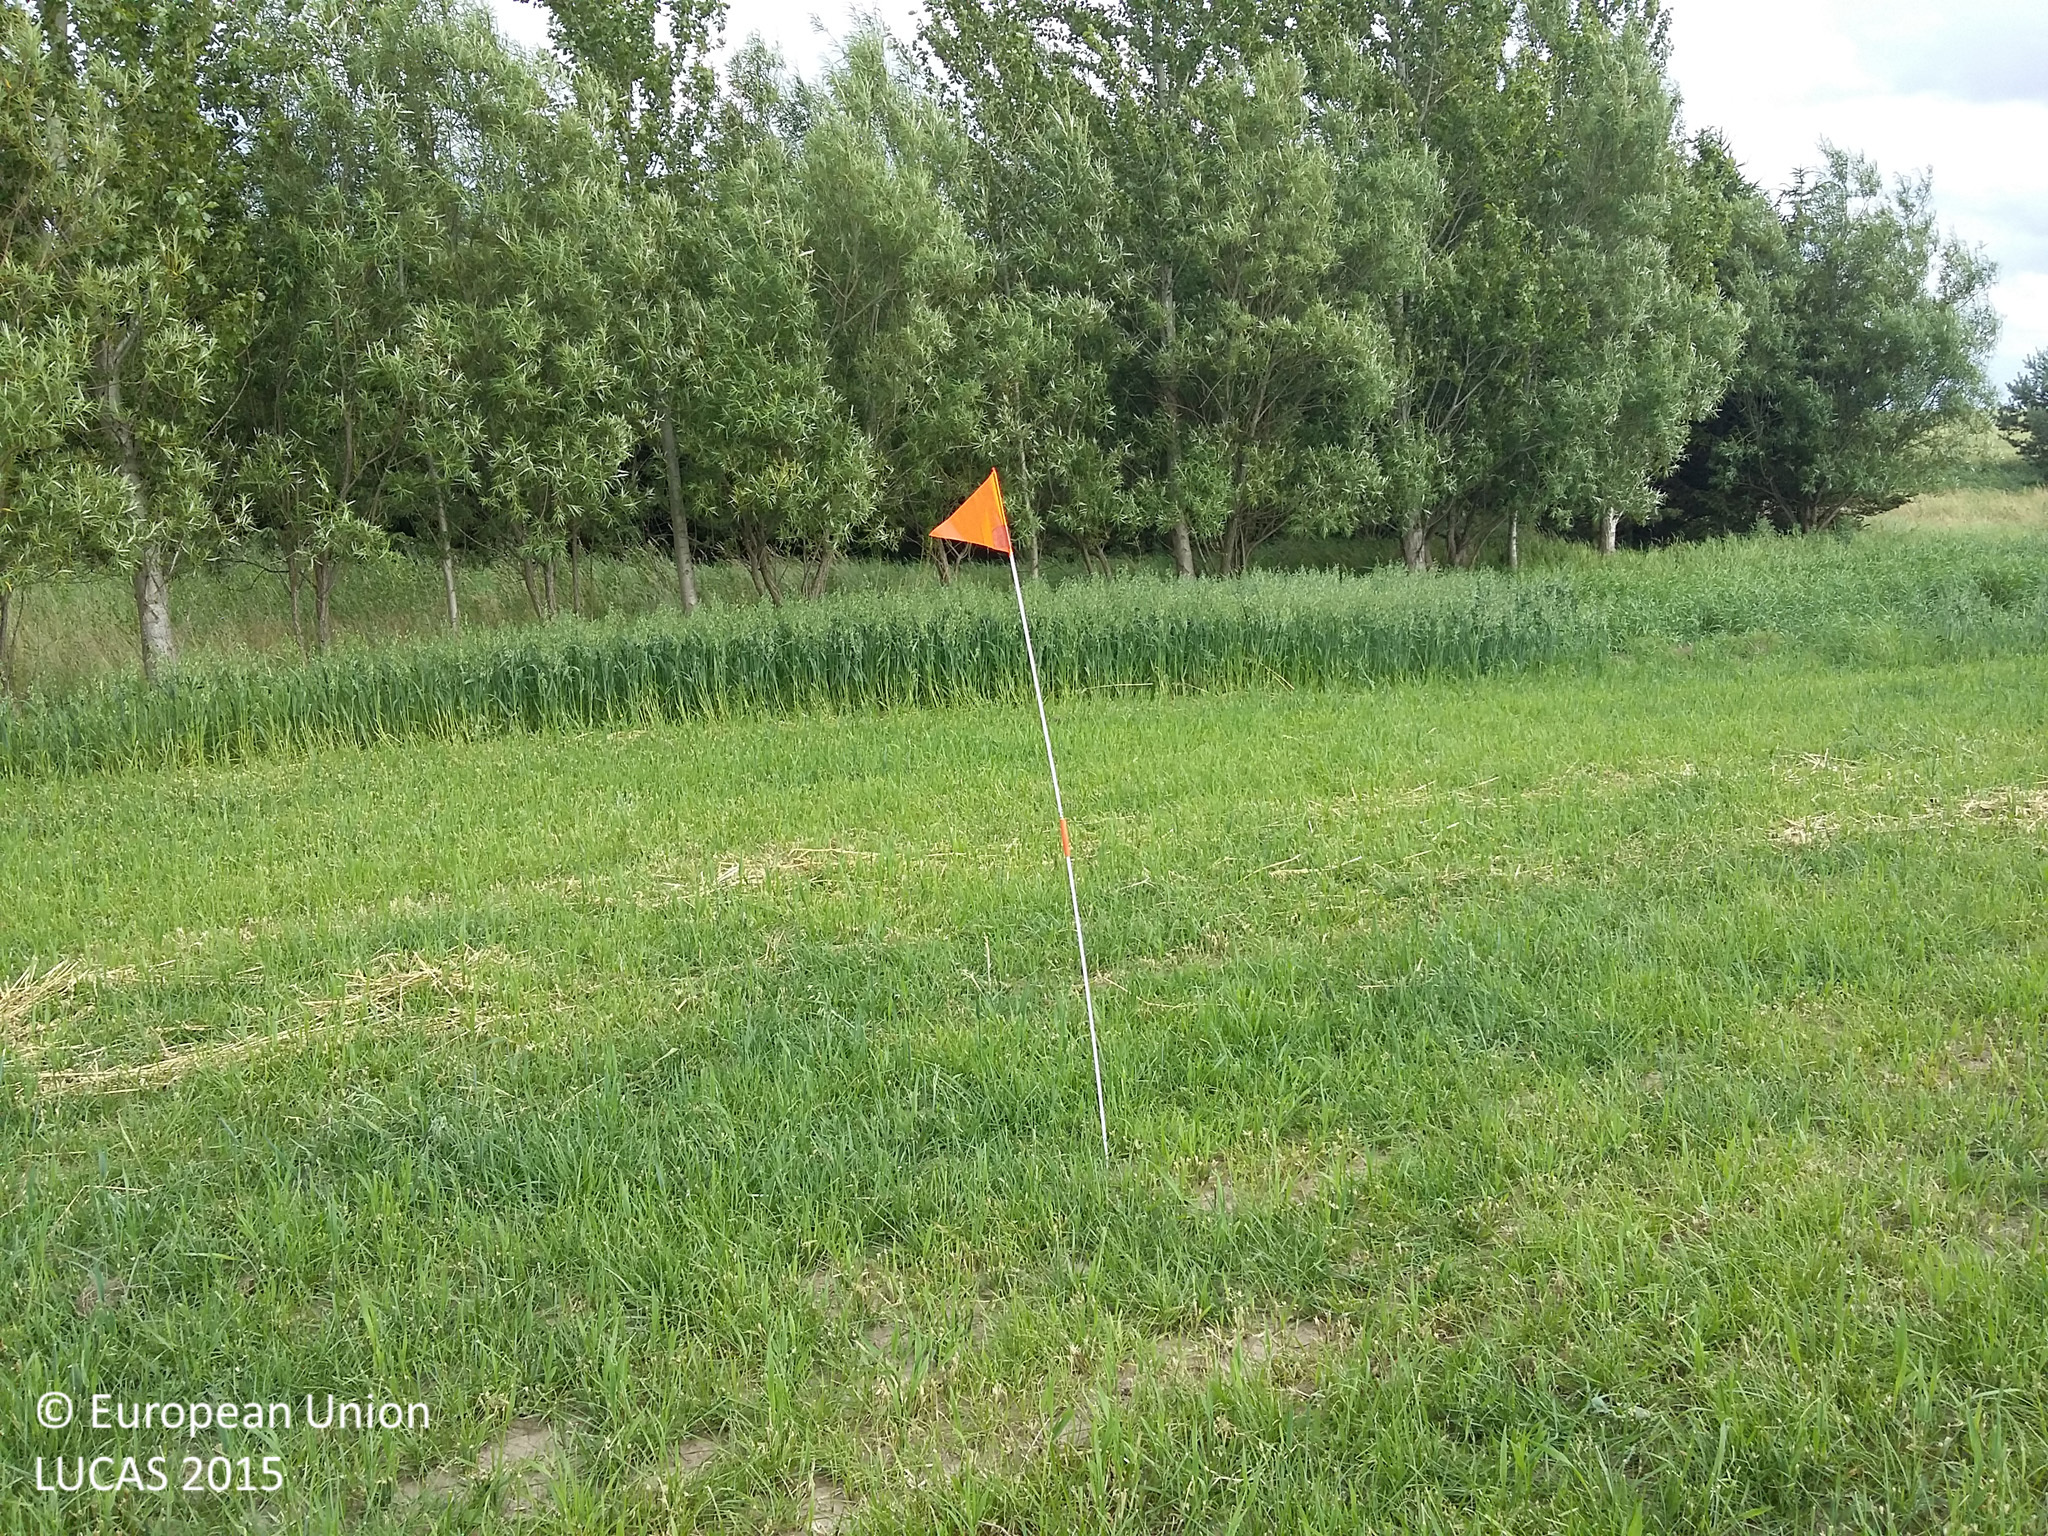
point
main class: Cropland
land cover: Oats
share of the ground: > 75 %
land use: Agriculture (excluding fallow land and kitchen gardens)
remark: Harvested field
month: July
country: DK
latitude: 55.4972
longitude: 11.3759
